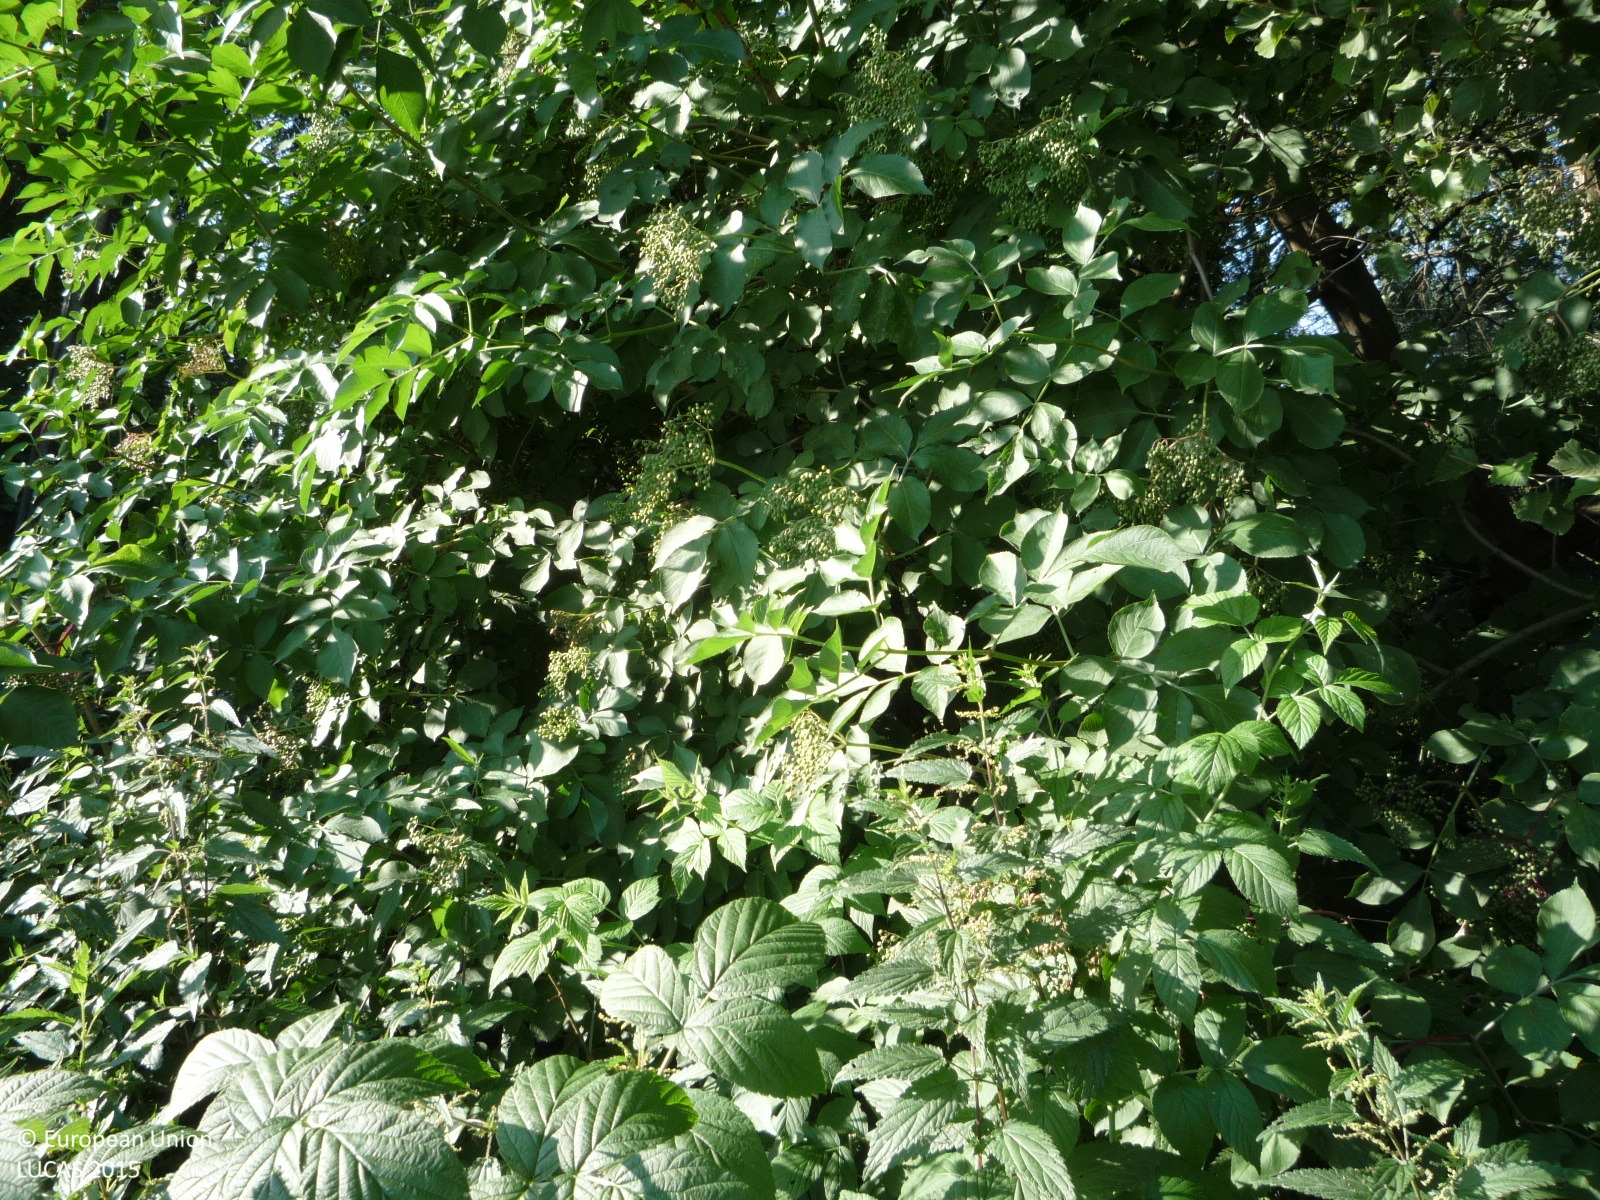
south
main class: Grassland
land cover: Grassland without tree/shrub cover
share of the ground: > 75 %
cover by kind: herbaceous plants 100 %
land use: Agriculture (excluding fallow land and kitchen gardens)
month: July
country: CZ
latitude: 50.4261
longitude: 15.1975
